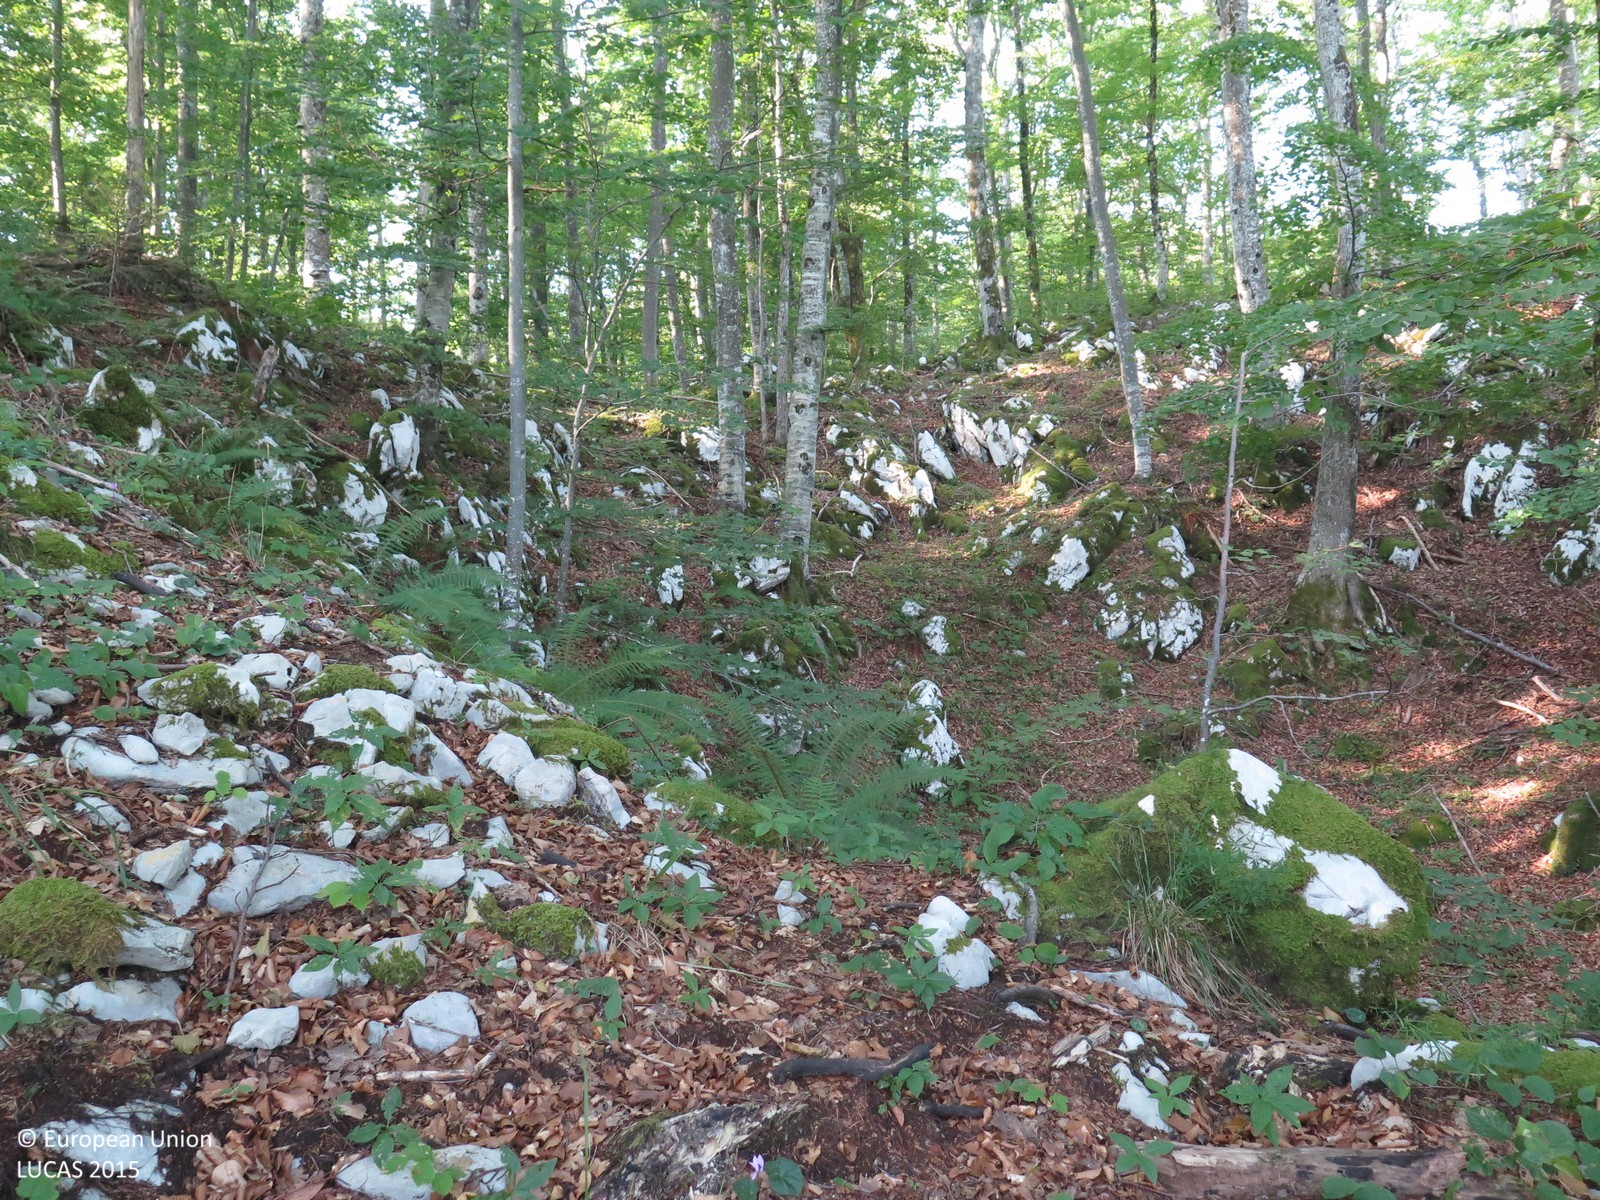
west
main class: Woodland
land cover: Broadleaved woodland
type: mountainous beech forest
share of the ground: > 75 %
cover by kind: broadleaved forest trees 90 %, herbaceous plants 5 %, unconsolidated bare surface 5 %
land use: Forestry
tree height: > 5 m
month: August
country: HR
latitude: 45.4943
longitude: 14.9990
